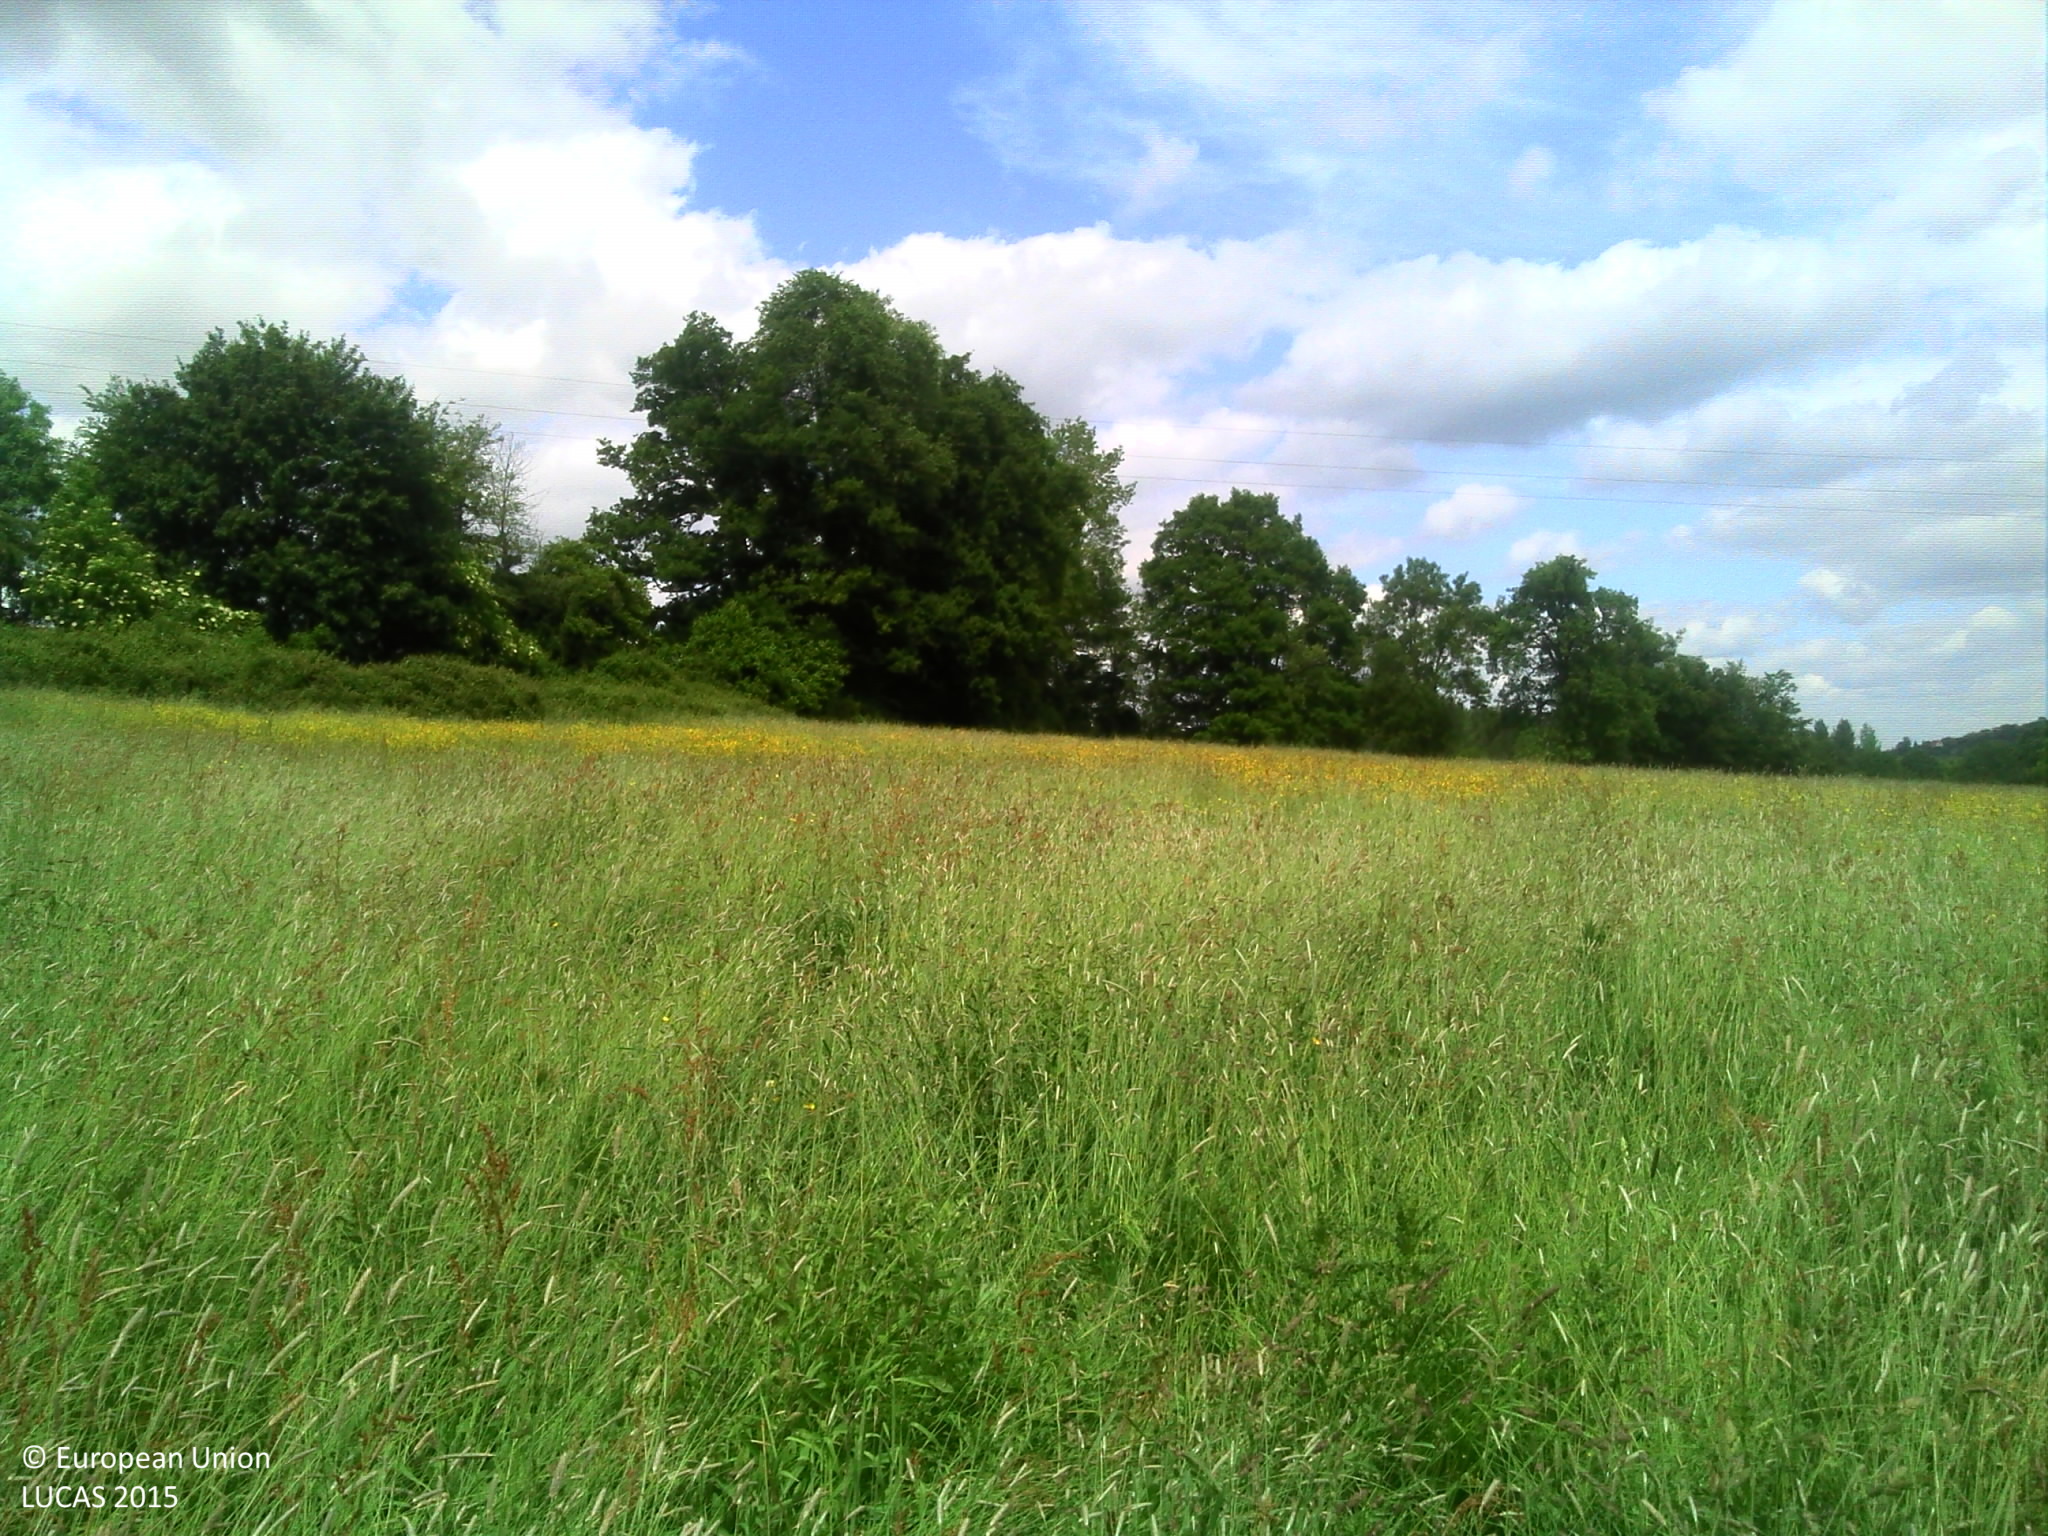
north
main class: Grassland
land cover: Grassland without tree/shrub cover
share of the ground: > 75 %
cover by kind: herbaceous plants 95 %
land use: Agriculture (excluding fallow land and kitchen gardens)
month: June
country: FR
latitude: 48.8989
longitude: 0.0804
